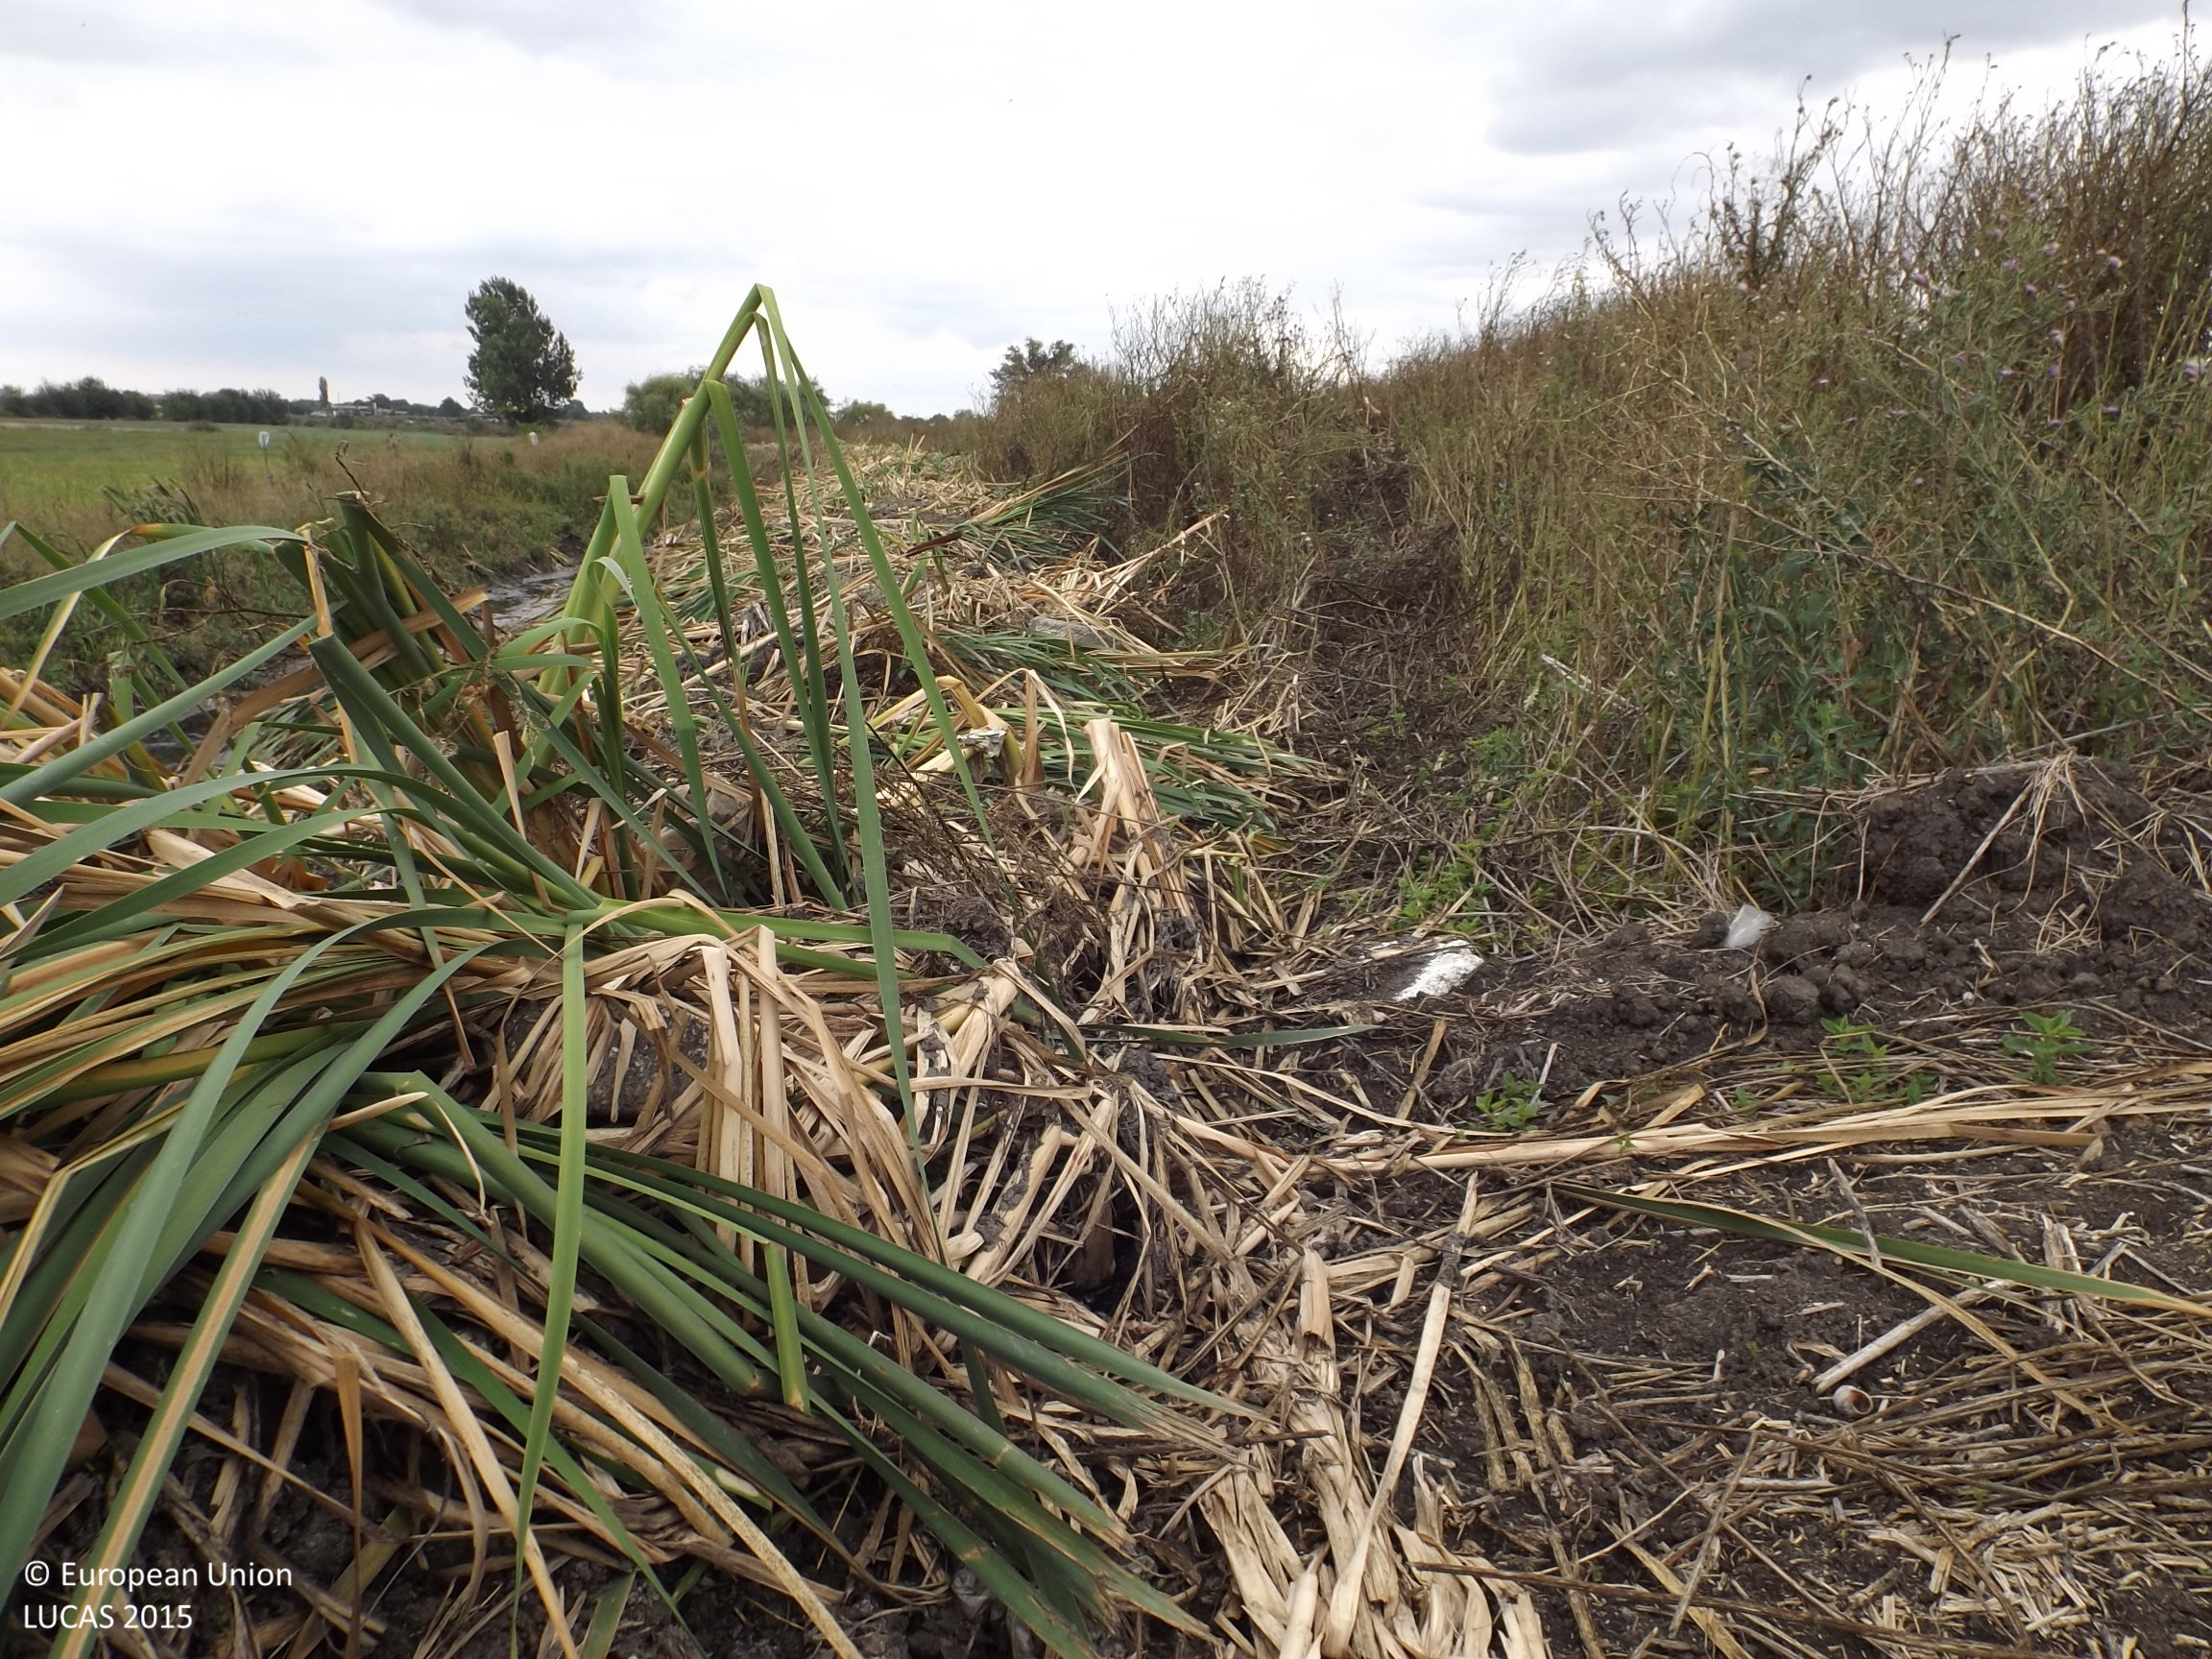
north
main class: Grassland
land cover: Grassland without tree/shrub cover
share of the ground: 10 - 25 %
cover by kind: herbaceous plants 100 %
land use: Agriculture (excluding fallow land and kitchen gardens)
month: August
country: BG
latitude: 43.3048
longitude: 27.4224
